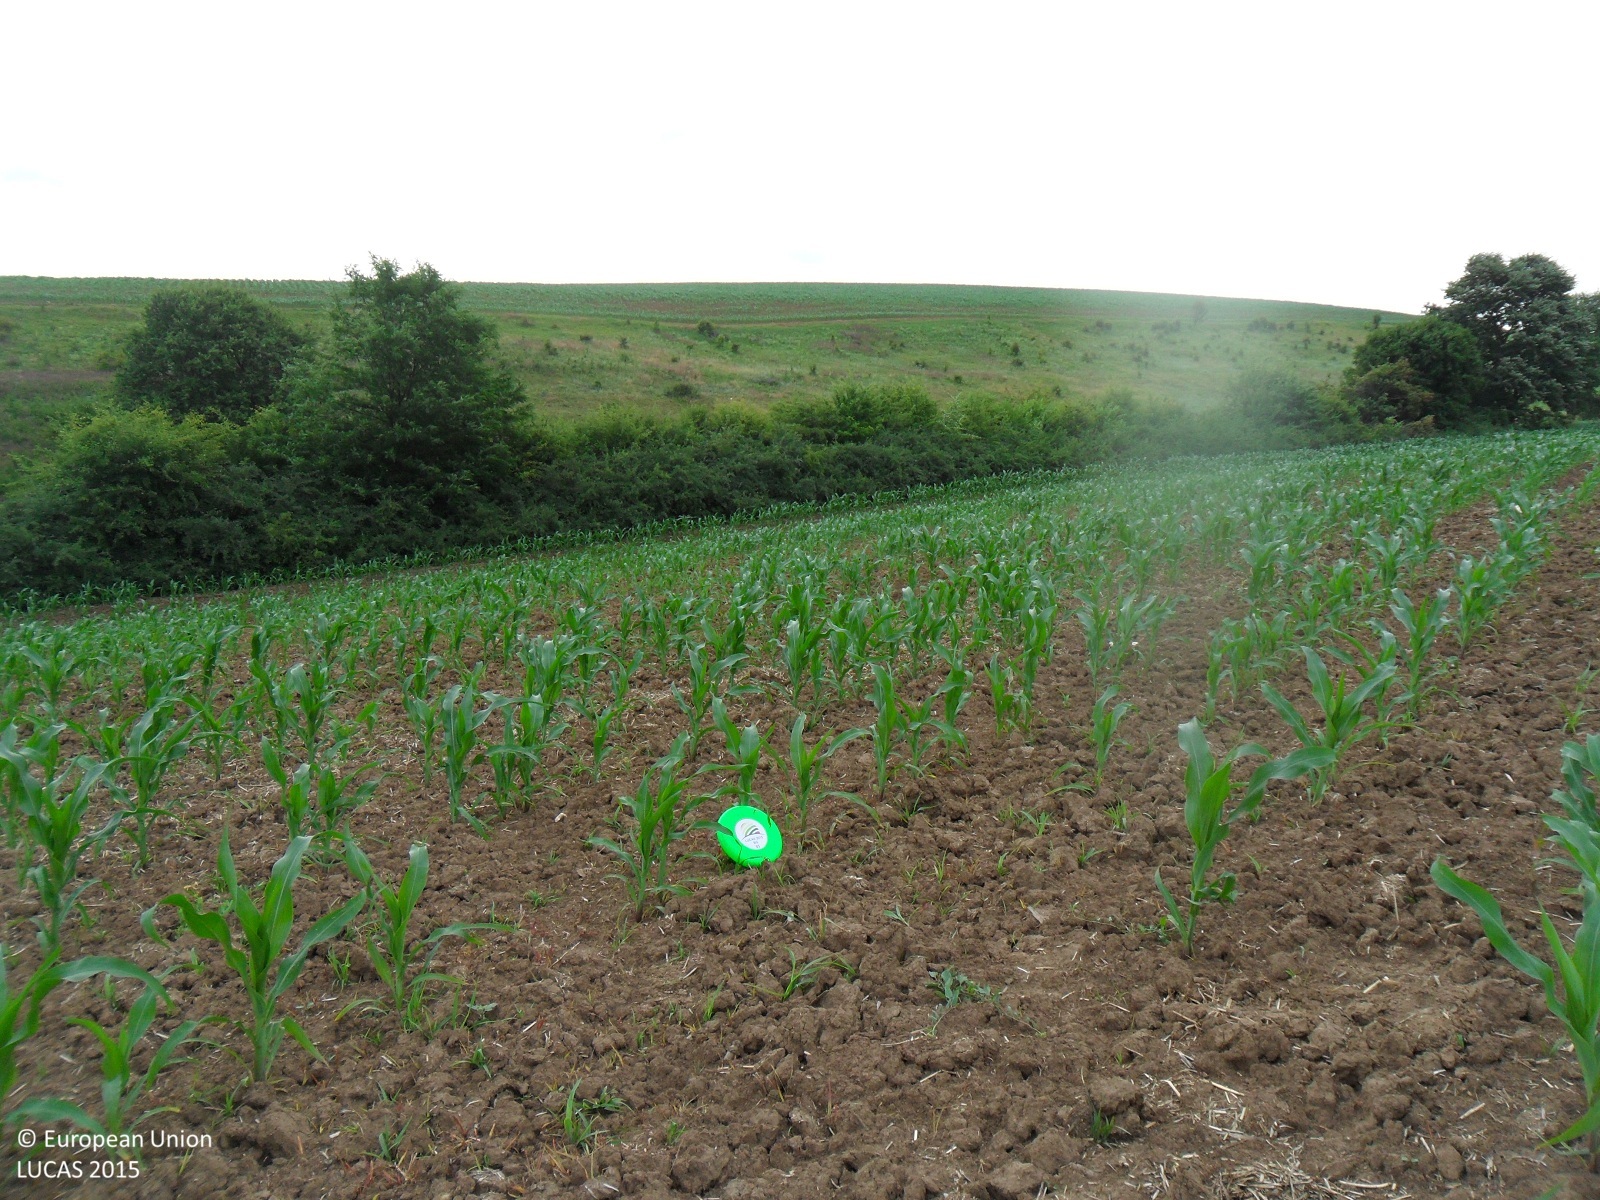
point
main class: Cropland
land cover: Maize
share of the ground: 25 - 50 %
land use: Agriculture (excluding fallow land and kitchen gardens)
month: June
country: BG
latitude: 43.7995
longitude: 26.7827
